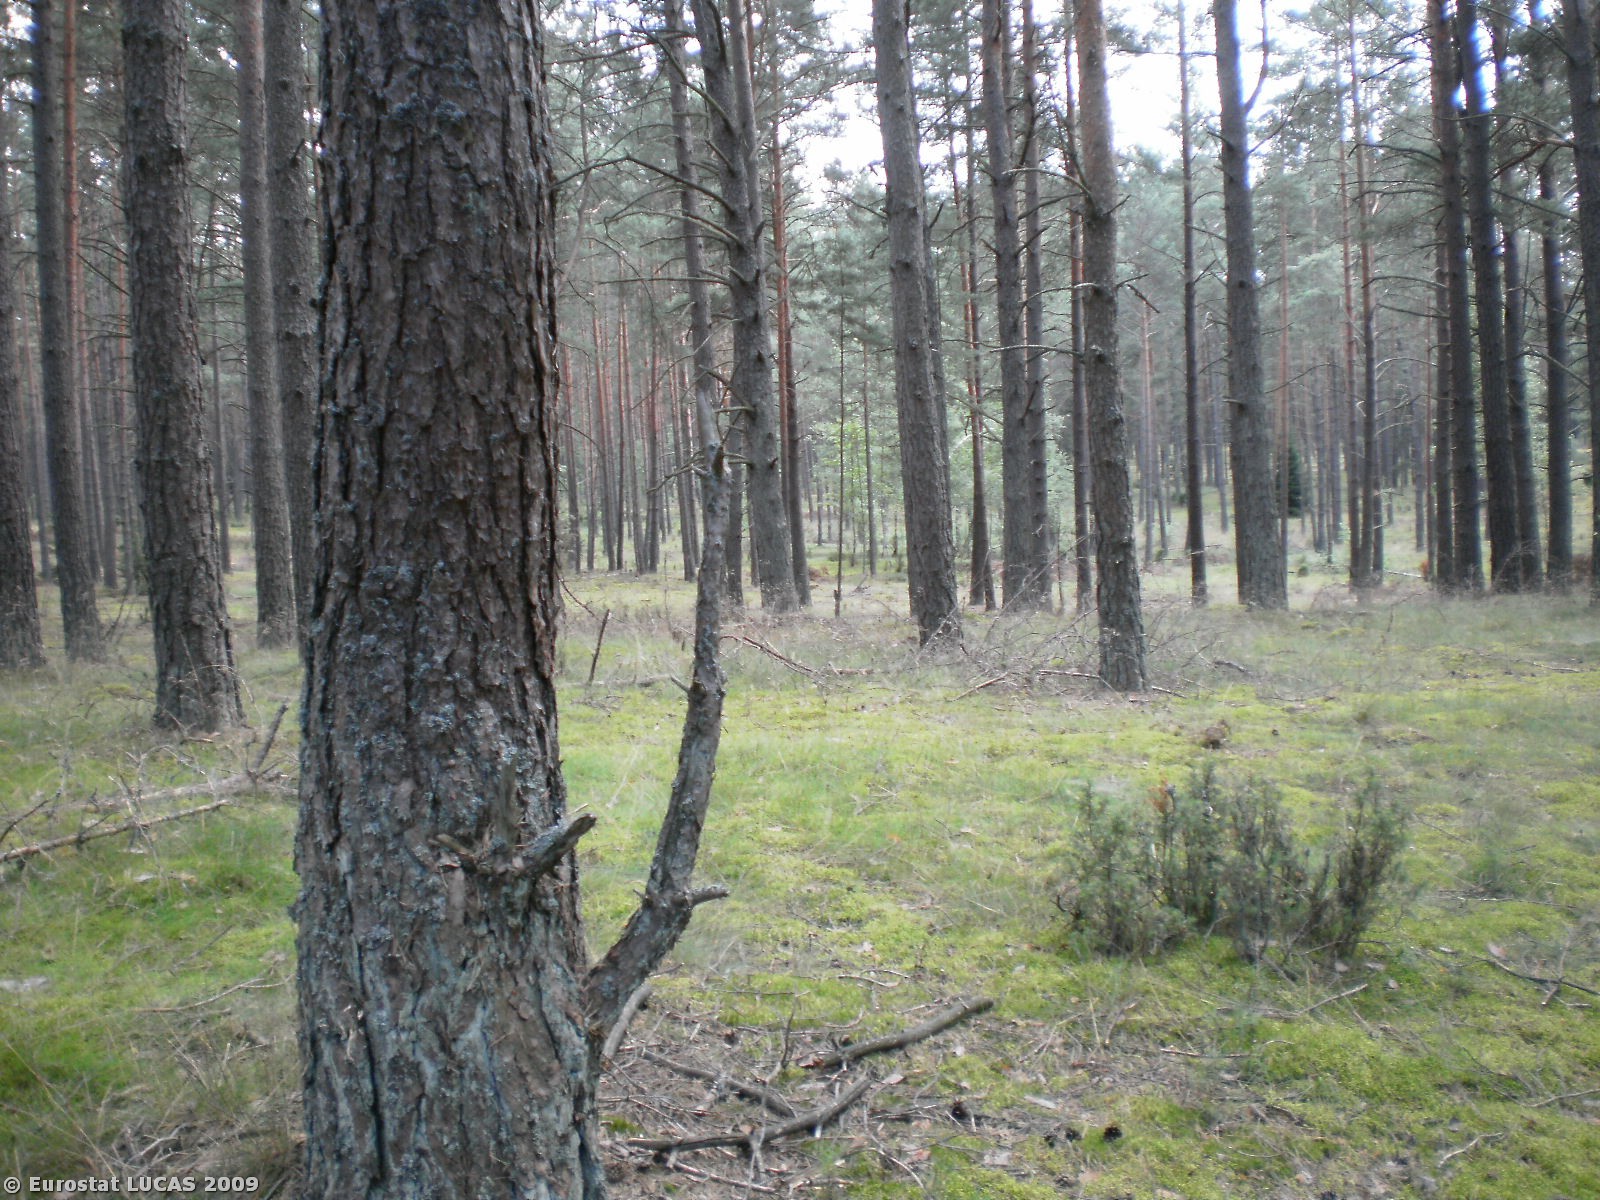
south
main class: Woodland
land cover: Coniferous woodland
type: hemiboreal forest and nemoral coniferous forest and mixed broadleaved-coniferous forest
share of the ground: 50 - 75 %
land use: Forestry
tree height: > 5 m
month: July
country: PL
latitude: 53.5483
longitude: 20.4352
